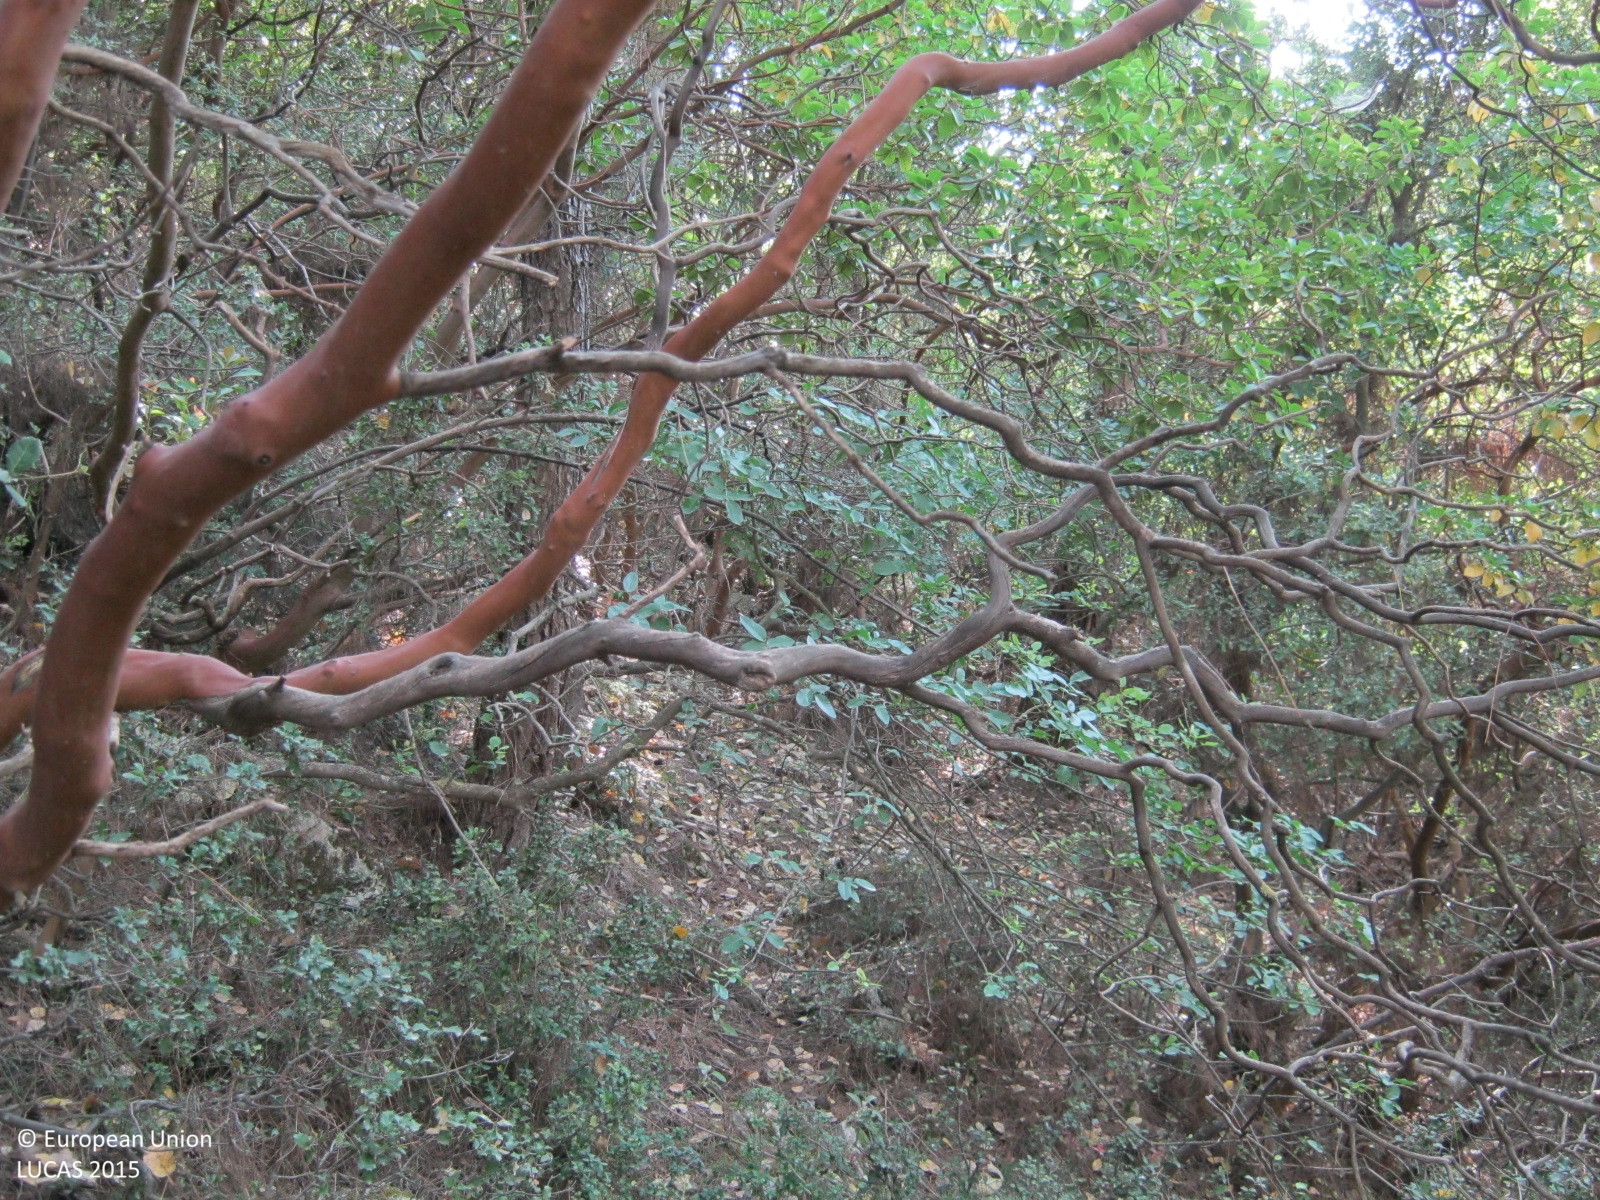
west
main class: Woodland
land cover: Other mixed woodland
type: coniferous forest of the mediterranean region
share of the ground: > 75 %
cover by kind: coniferous forest trees 55 %, broadleaved forest trees 25 %, shrubs 10 %, herbaceous plants 5 %, unconsolidated bare surface 5 %
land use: Semi-natural and natural areas not in use
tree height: > 5 m
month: June
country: GR
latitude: 35.3469
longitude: 23.7461
